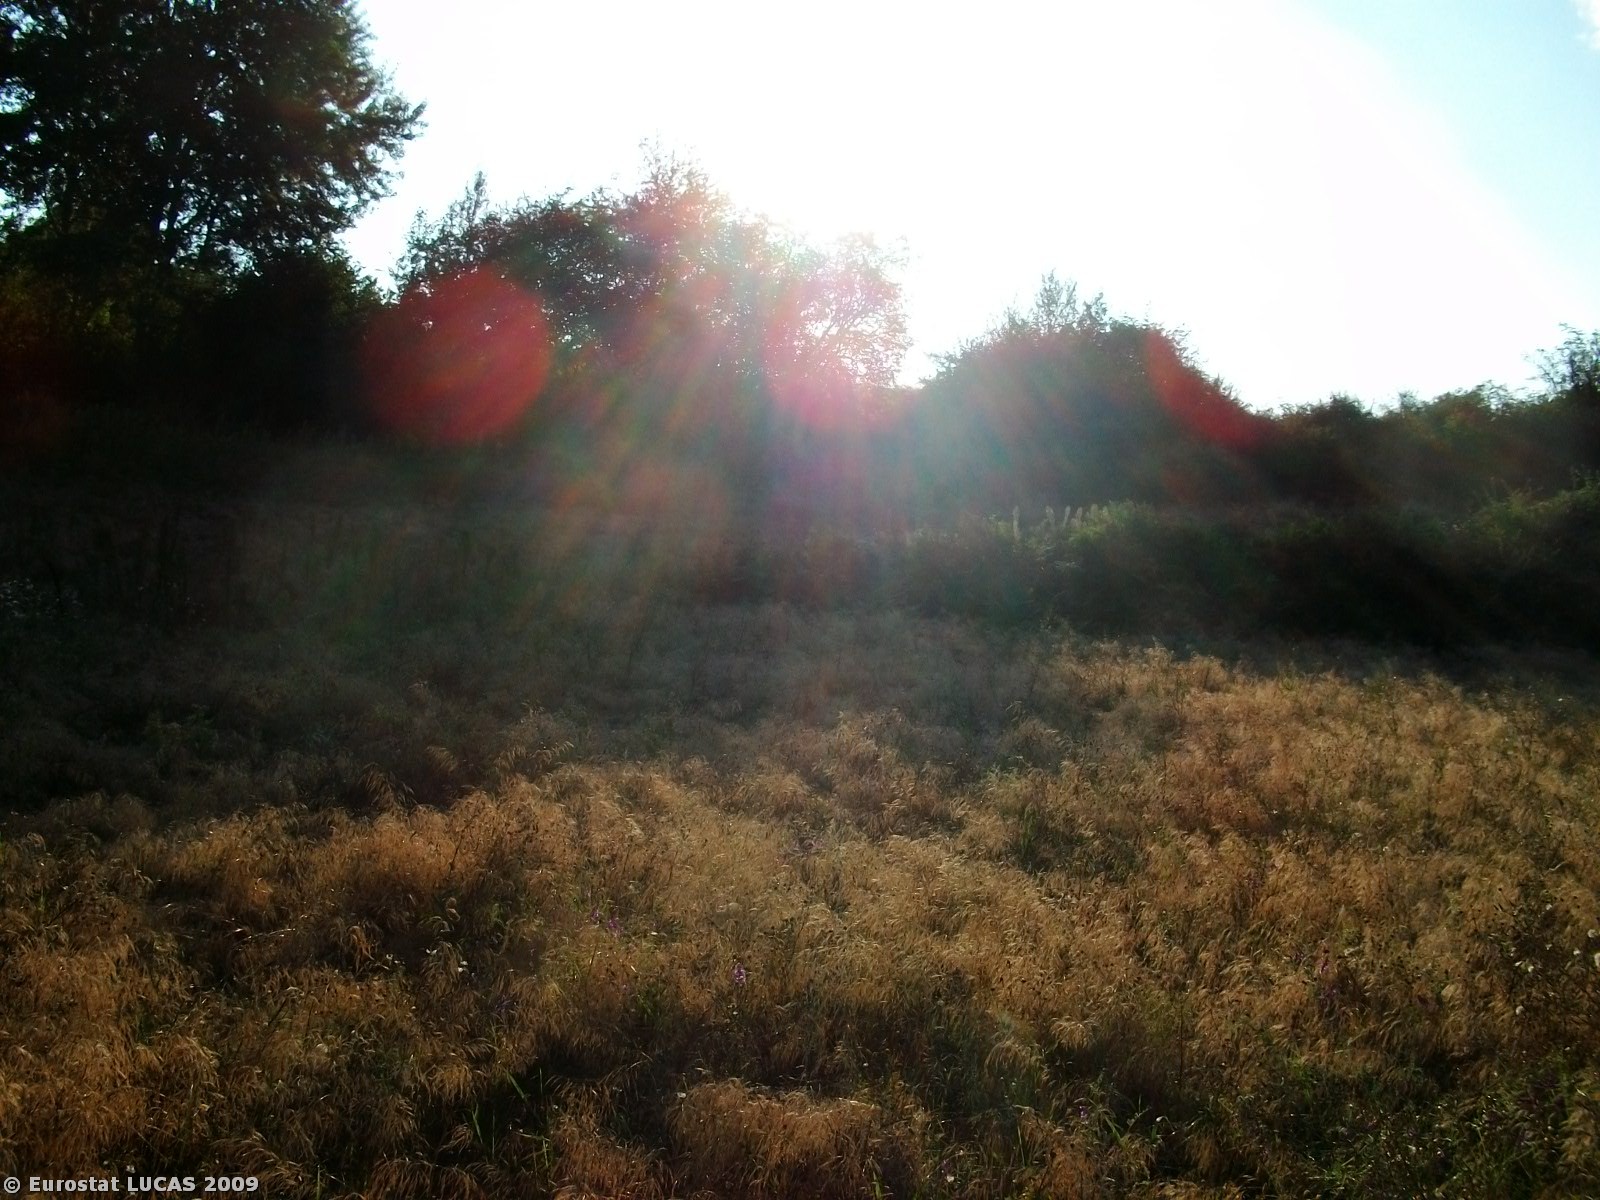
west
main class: Grassland
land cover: Grassland without tree/shrub cover
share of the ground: > 75 %
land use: Unused
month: September
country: GR
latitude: 41.2798
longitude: 23.6946
